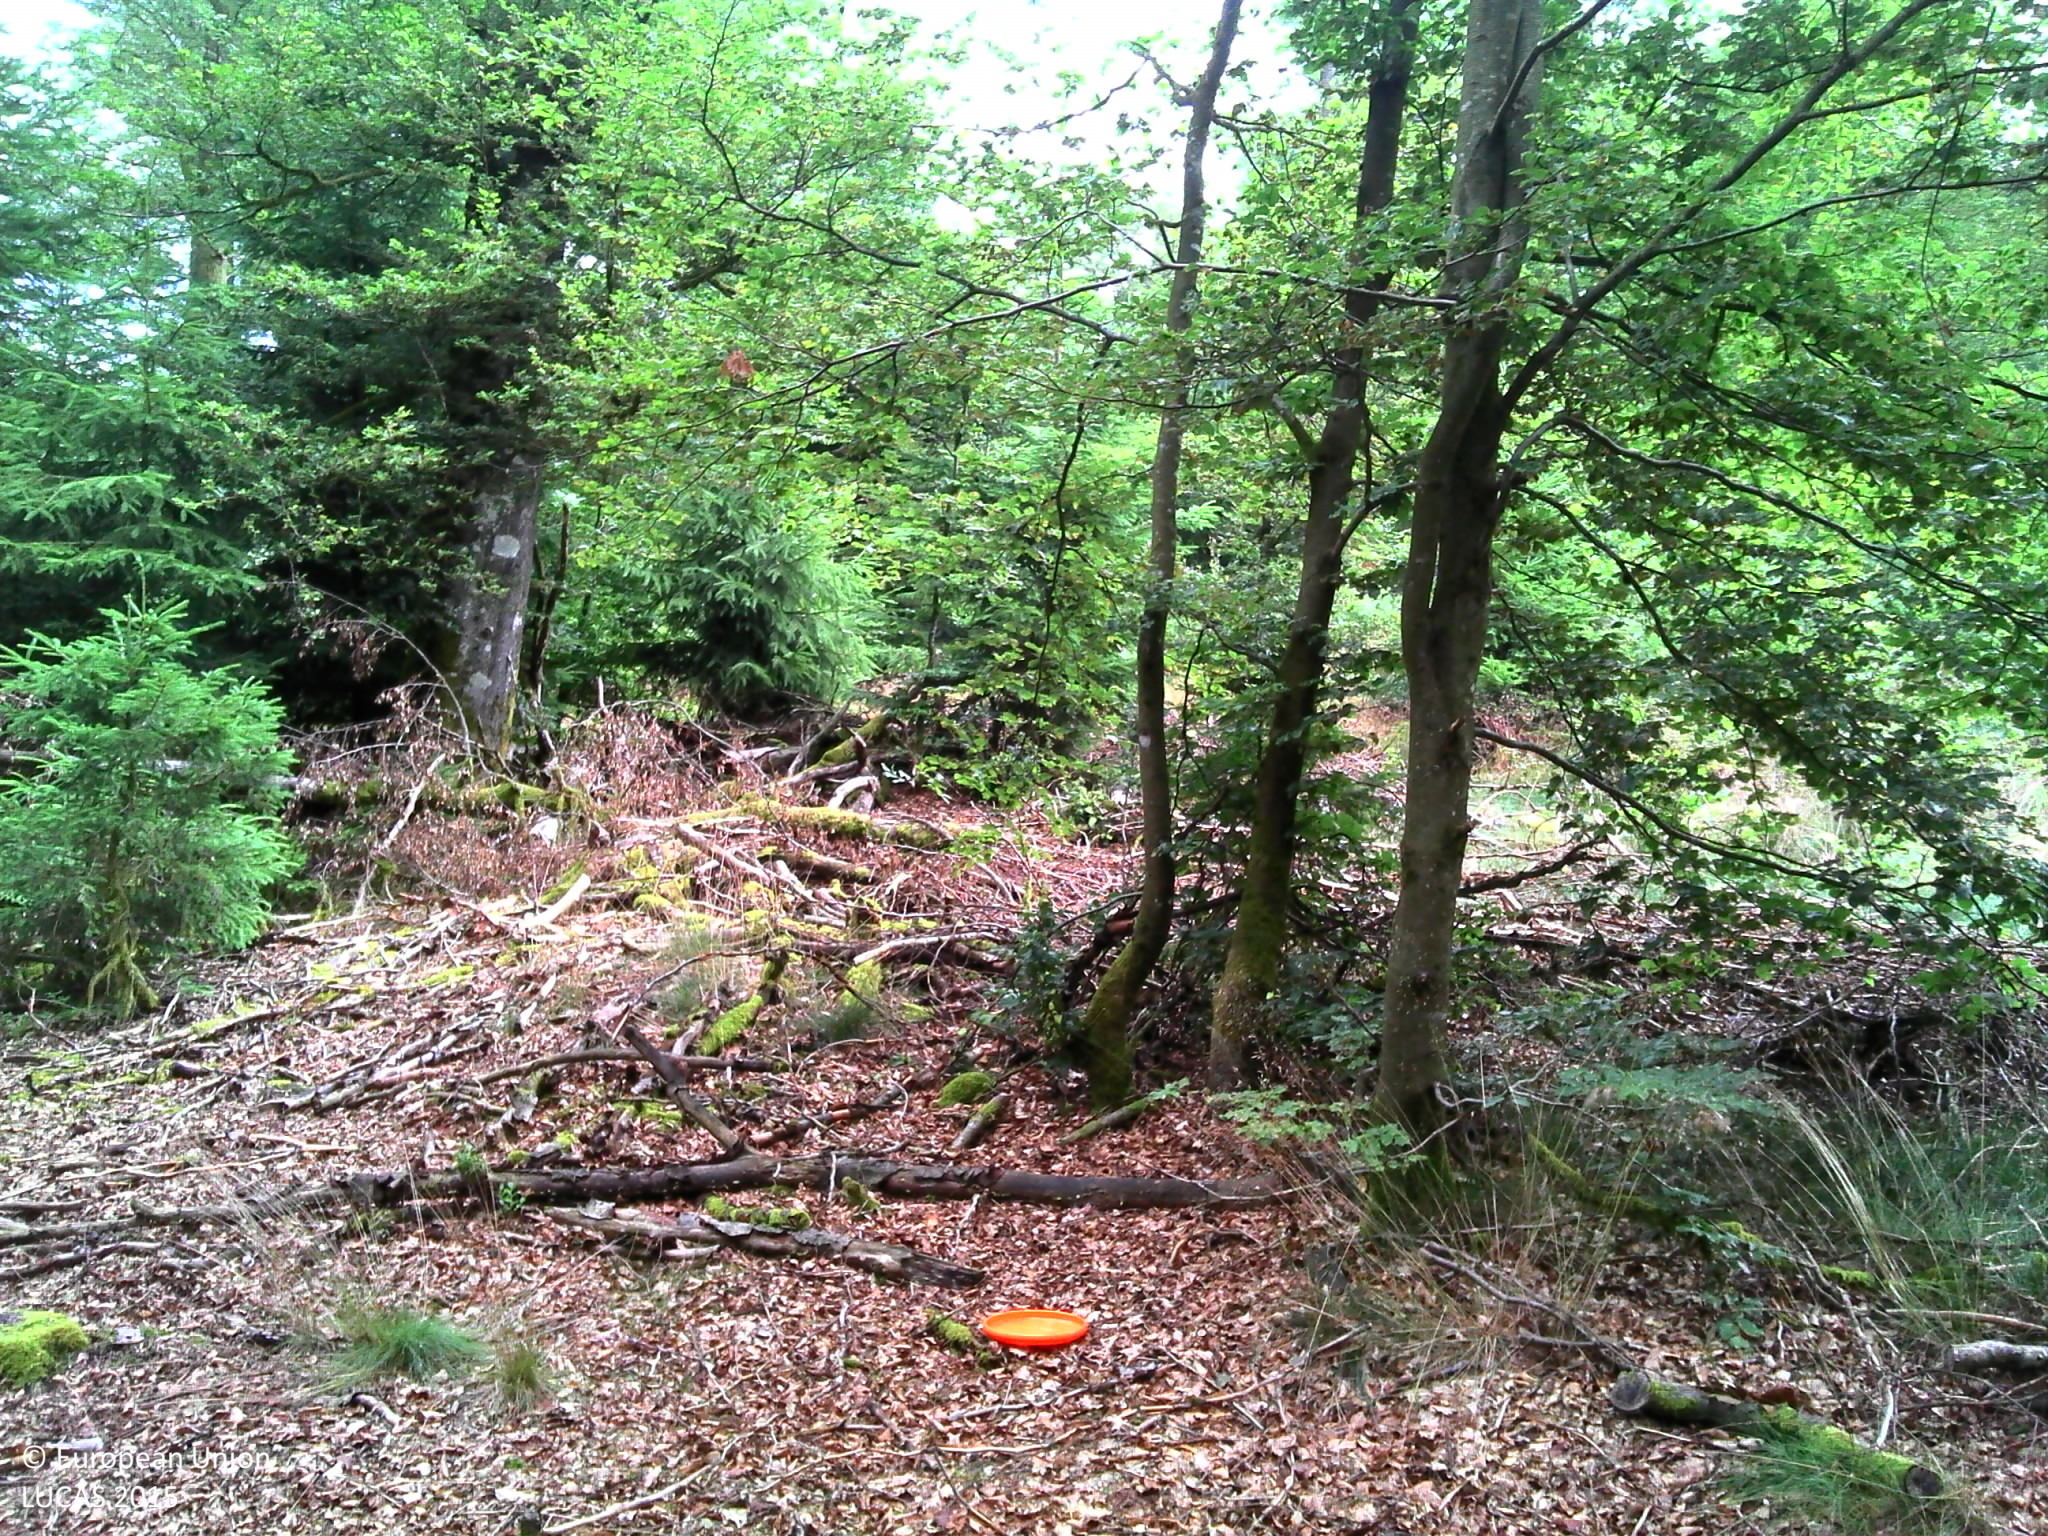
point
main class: Woodland
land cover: Broadleaved woodland
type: beech forest
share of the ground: 50 - 75 %
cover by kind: broadleaved forest trees 50 %, unconsolidated bare surface 25 %, herbaceous plants 20 %, coniferous forest trees 5 %
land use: Forestry
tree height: > 5 m
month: July
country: BE
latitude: 49.7662
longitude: 5.3749
